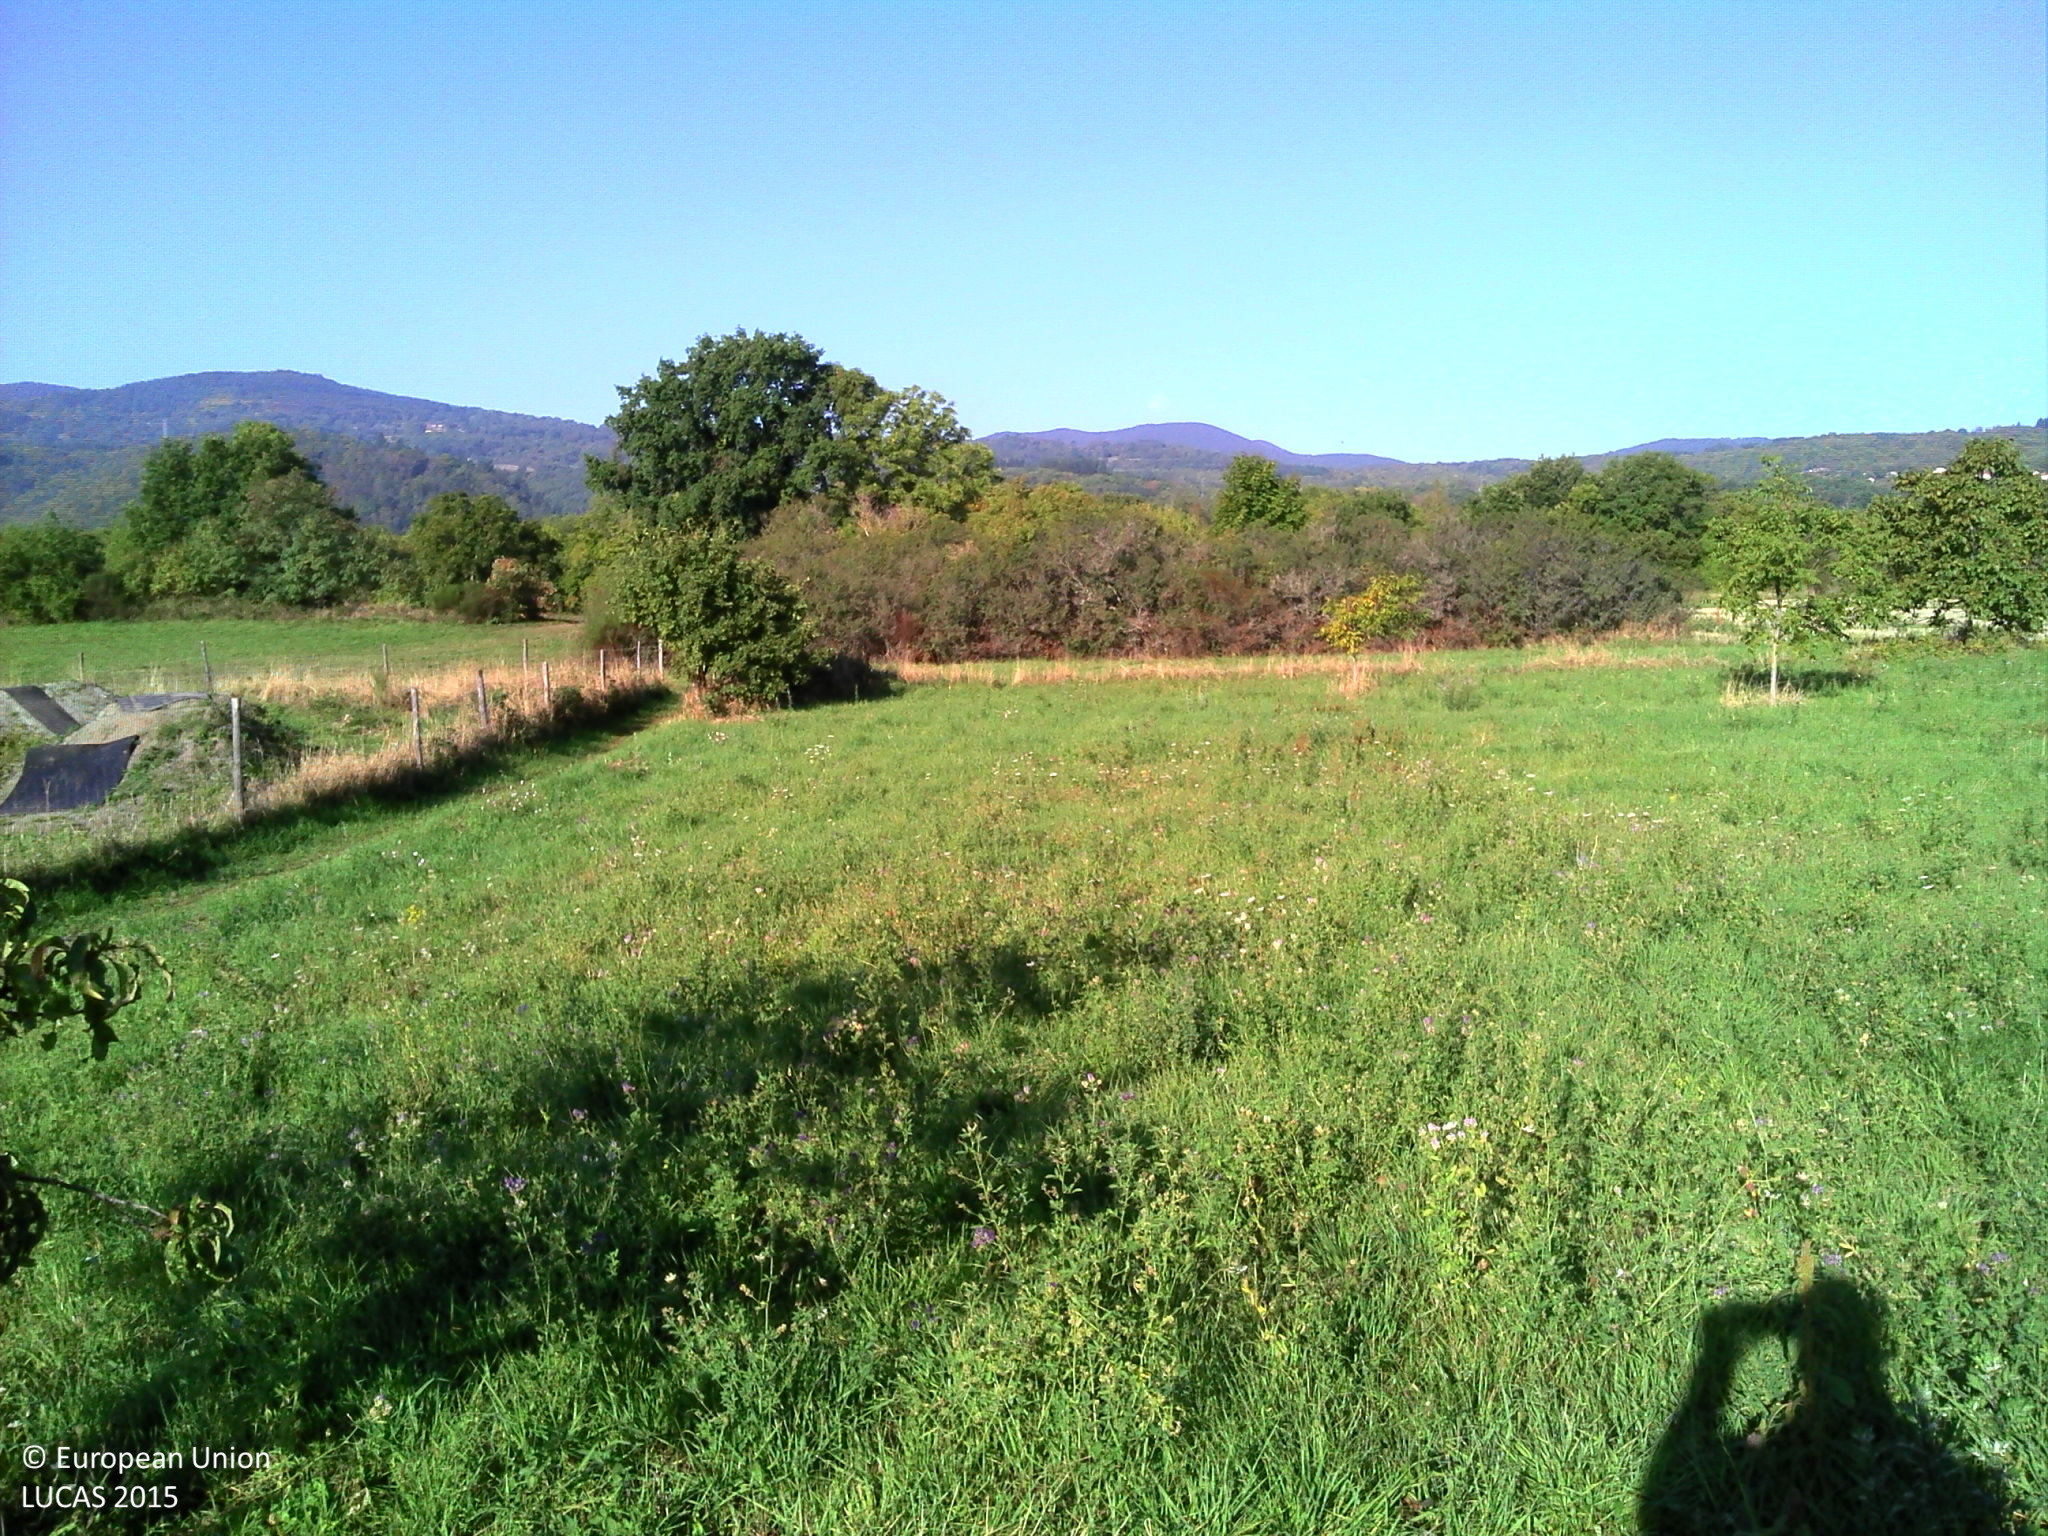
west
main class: Grassland
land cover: Grassland with sparse tree/shrub cover
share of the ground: > 75 %
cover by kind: herbaceous plants 95 %, broadleaved forest trees 5 %
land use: Agriculture (excluding fallow land and kitchen gardens)
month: September
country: FR
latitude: 45.8364
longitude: 3.0600
